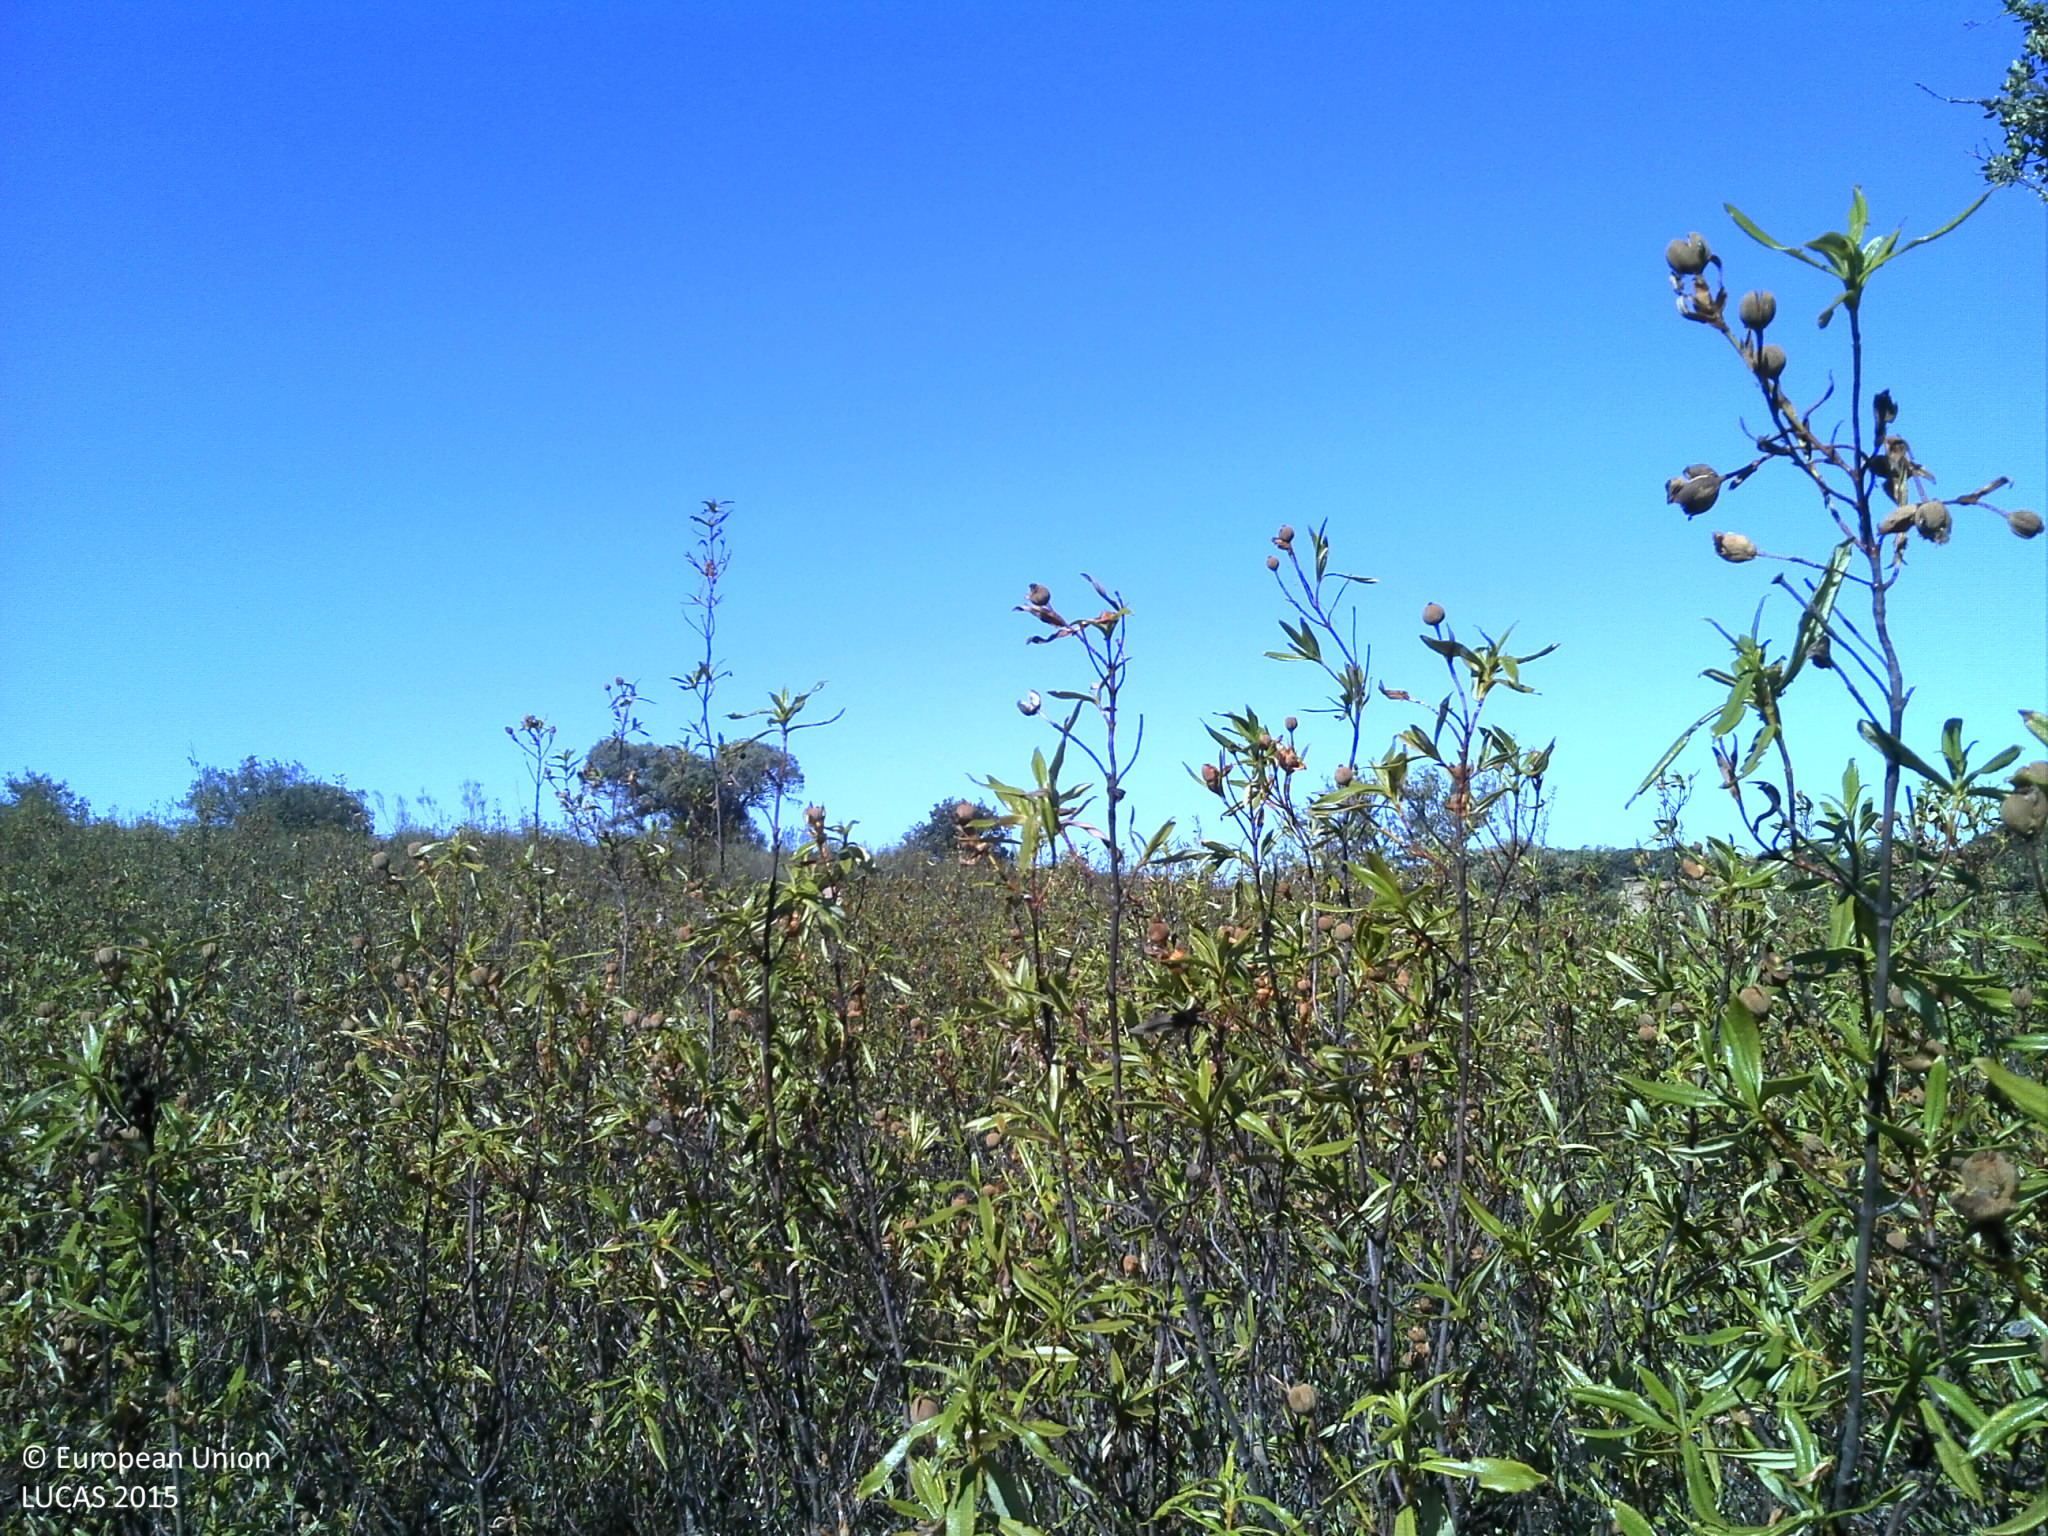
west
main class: Woodland
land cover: Broadleaved woodland
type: broadleaved evergreen forest
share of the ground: 10 - 25 %
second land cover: Shrubland without tree cover
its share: > 75 %
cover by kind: shrubs 85 %, broadleaved forest trees 15 %
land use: Forestry
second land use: Agriculture (excluding fallow land and kitchen gardens)
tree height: > 5 m
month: July
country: PT
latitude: 38.9230
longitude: -7.4873
